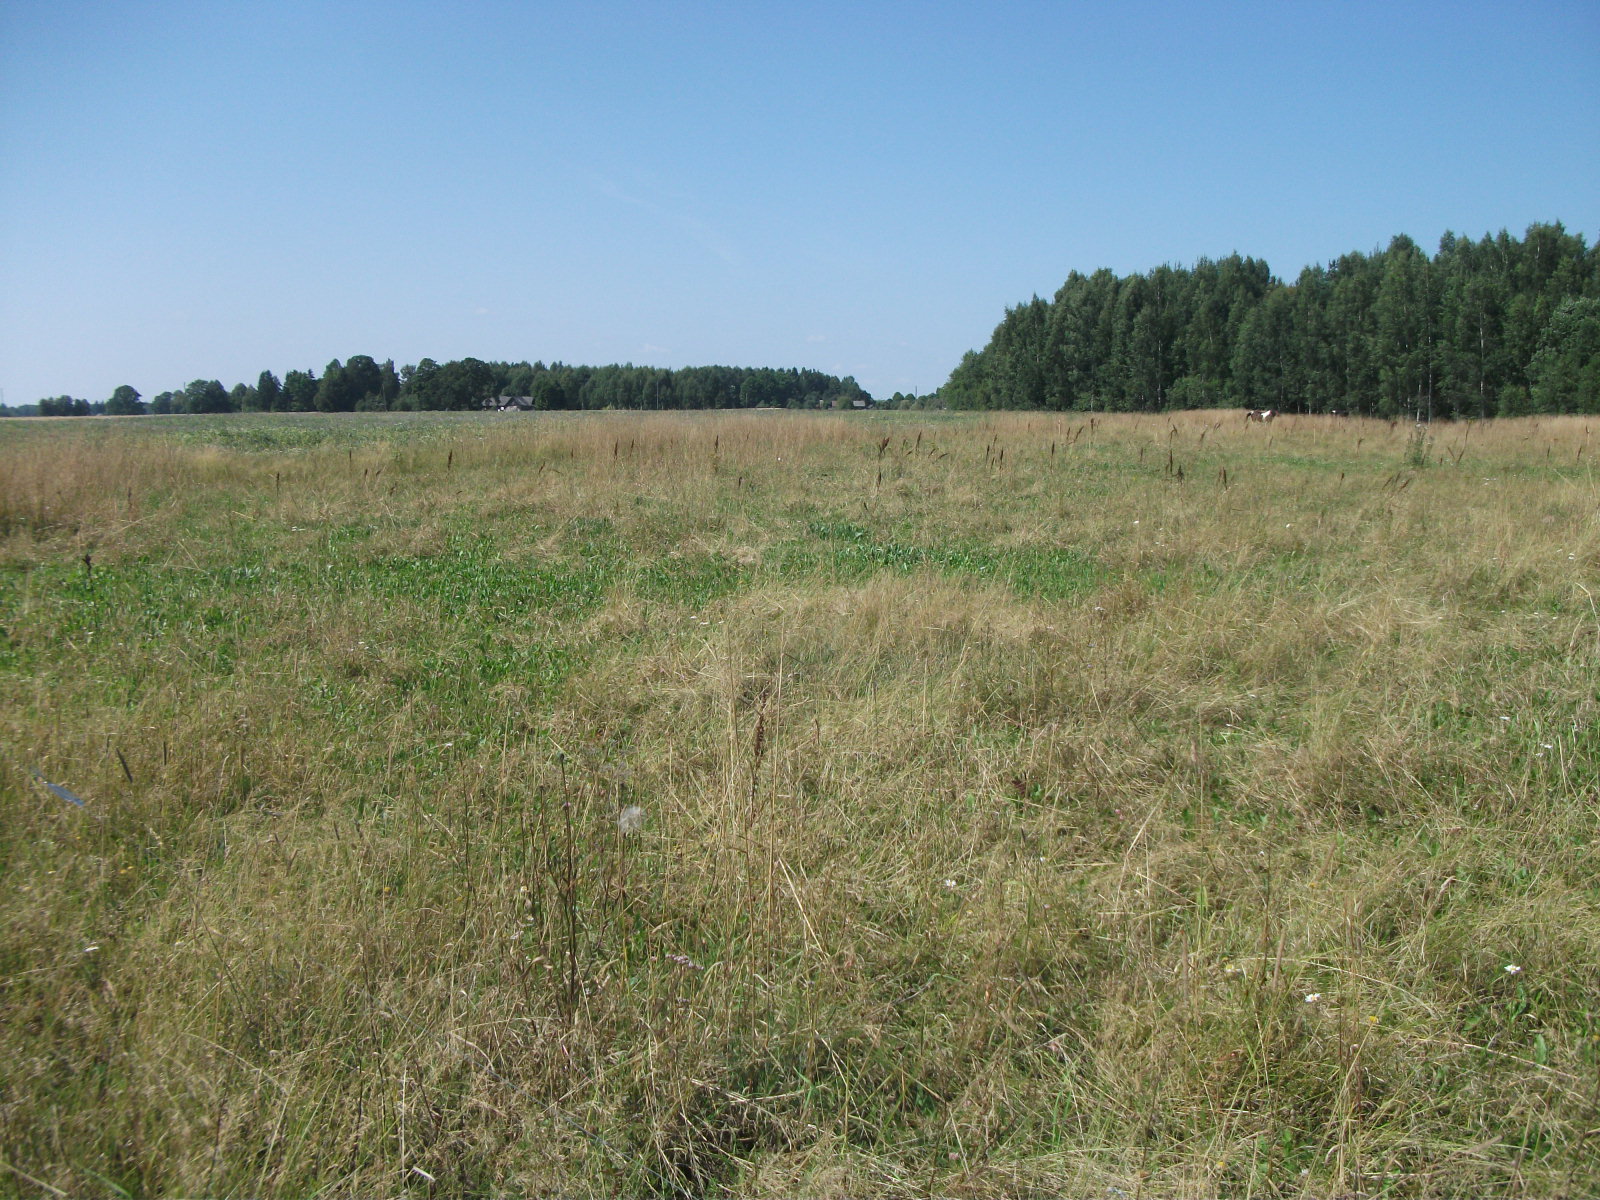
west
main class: Grassland
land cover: Grassland without tree/shrub cover
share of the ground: > 75 %
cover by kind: herbaceous plants 100 %
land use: Agriculture (excluding fallow land and kitchen gardens)
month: August
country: LV
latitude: 56.6534
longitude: 26.5075
